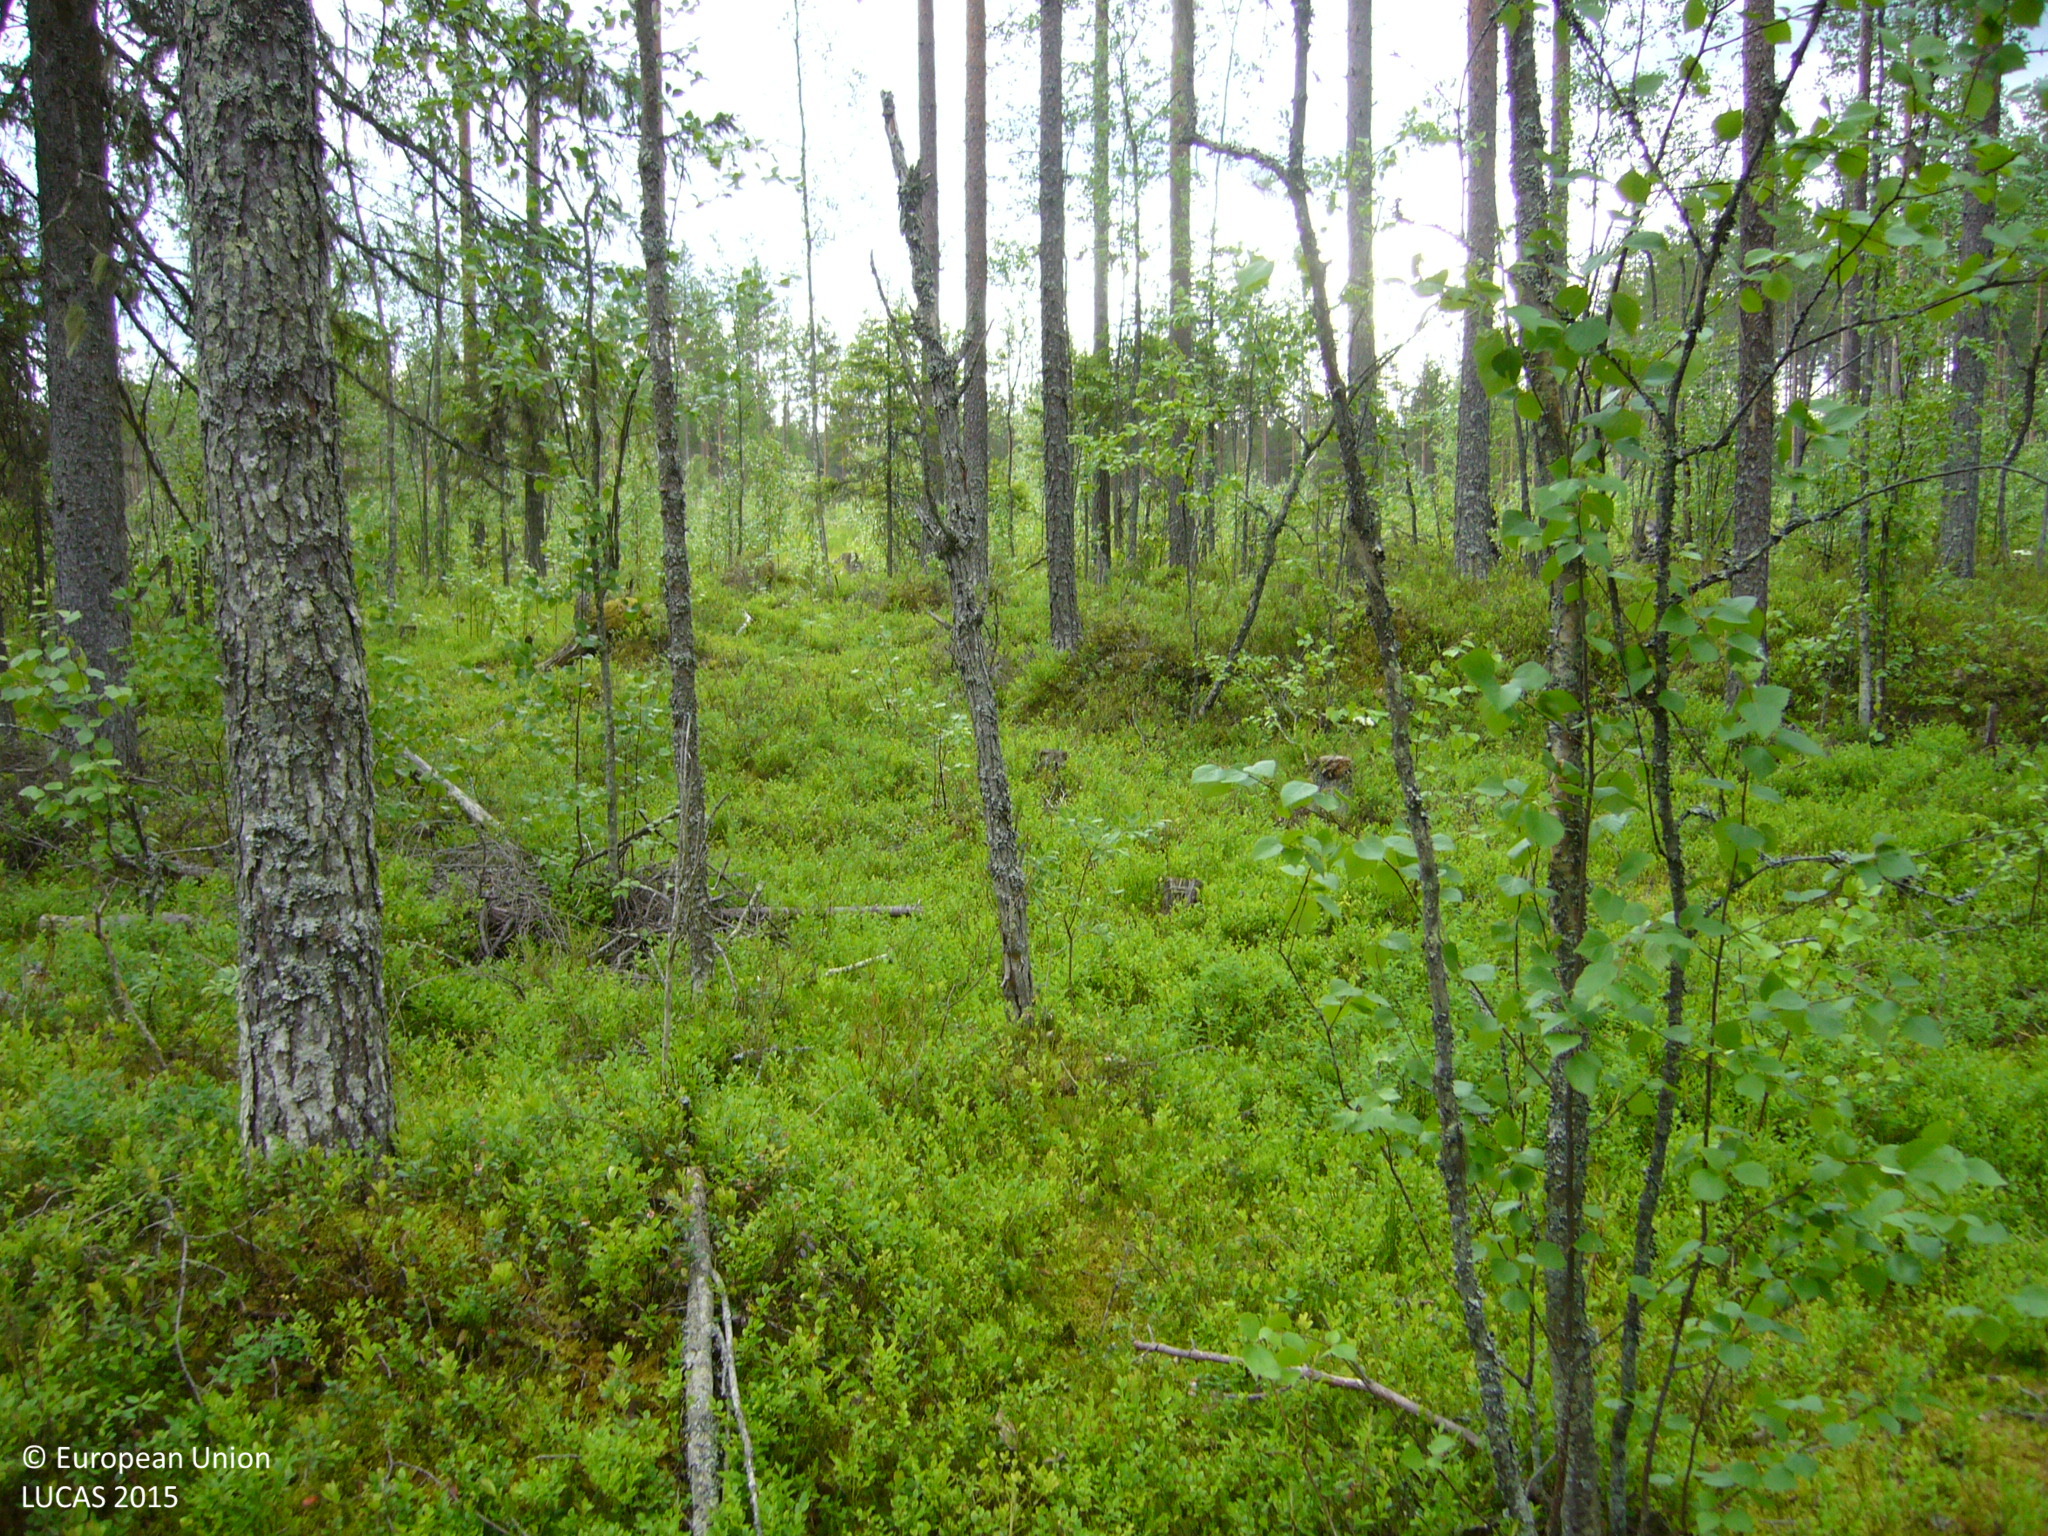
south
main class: Woodland
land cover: Pine dominated mixed woodland
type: boreal forest
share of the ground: > 75 %
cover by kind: coniferous forest trees 60 %, broadleaved forest trees 30 %, shrubs 10 %
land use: Forestry
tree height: > 5 m
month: June
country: FI
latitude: 63.8399
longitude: 26.1536
